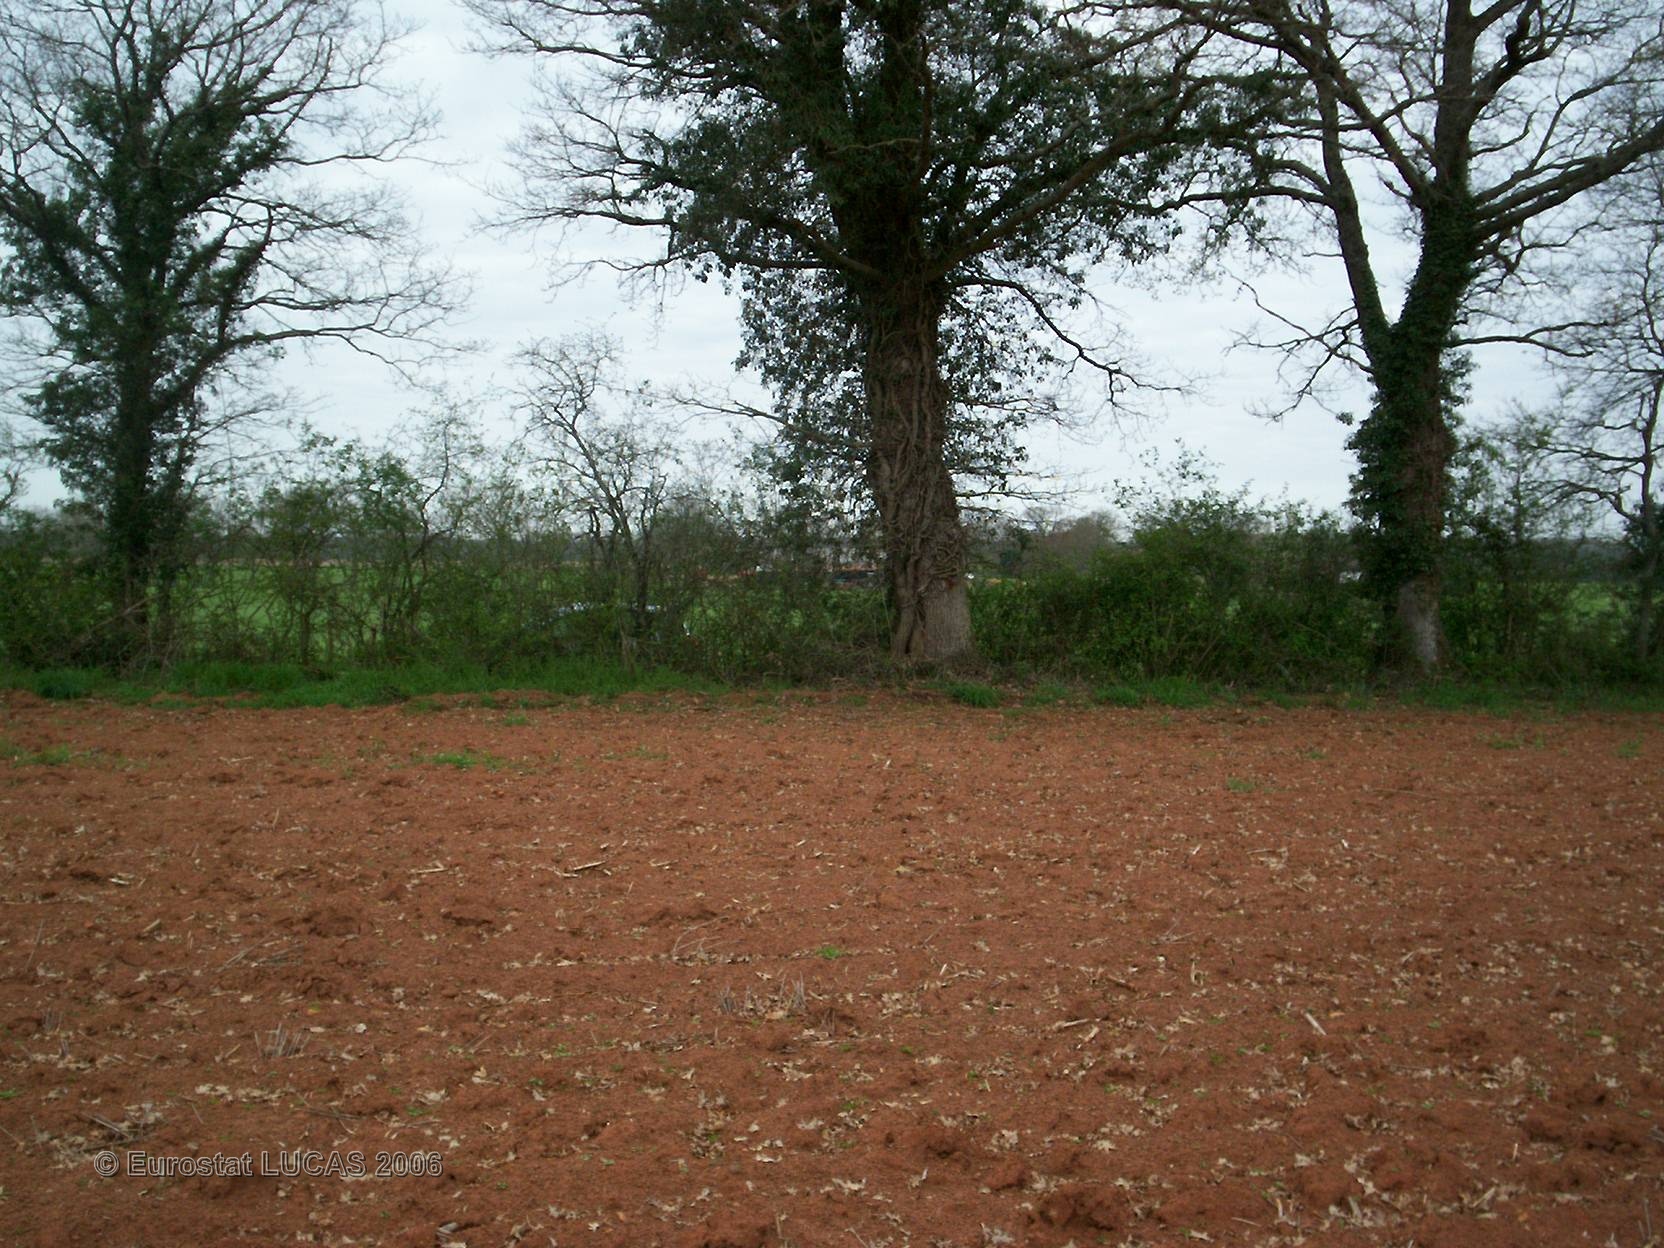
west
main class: Cropland
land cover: Maize
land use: Agriculture (excluding fallow land and kitchen gardens)
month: May
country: FR
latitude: 46.1313
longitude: 0.5490
